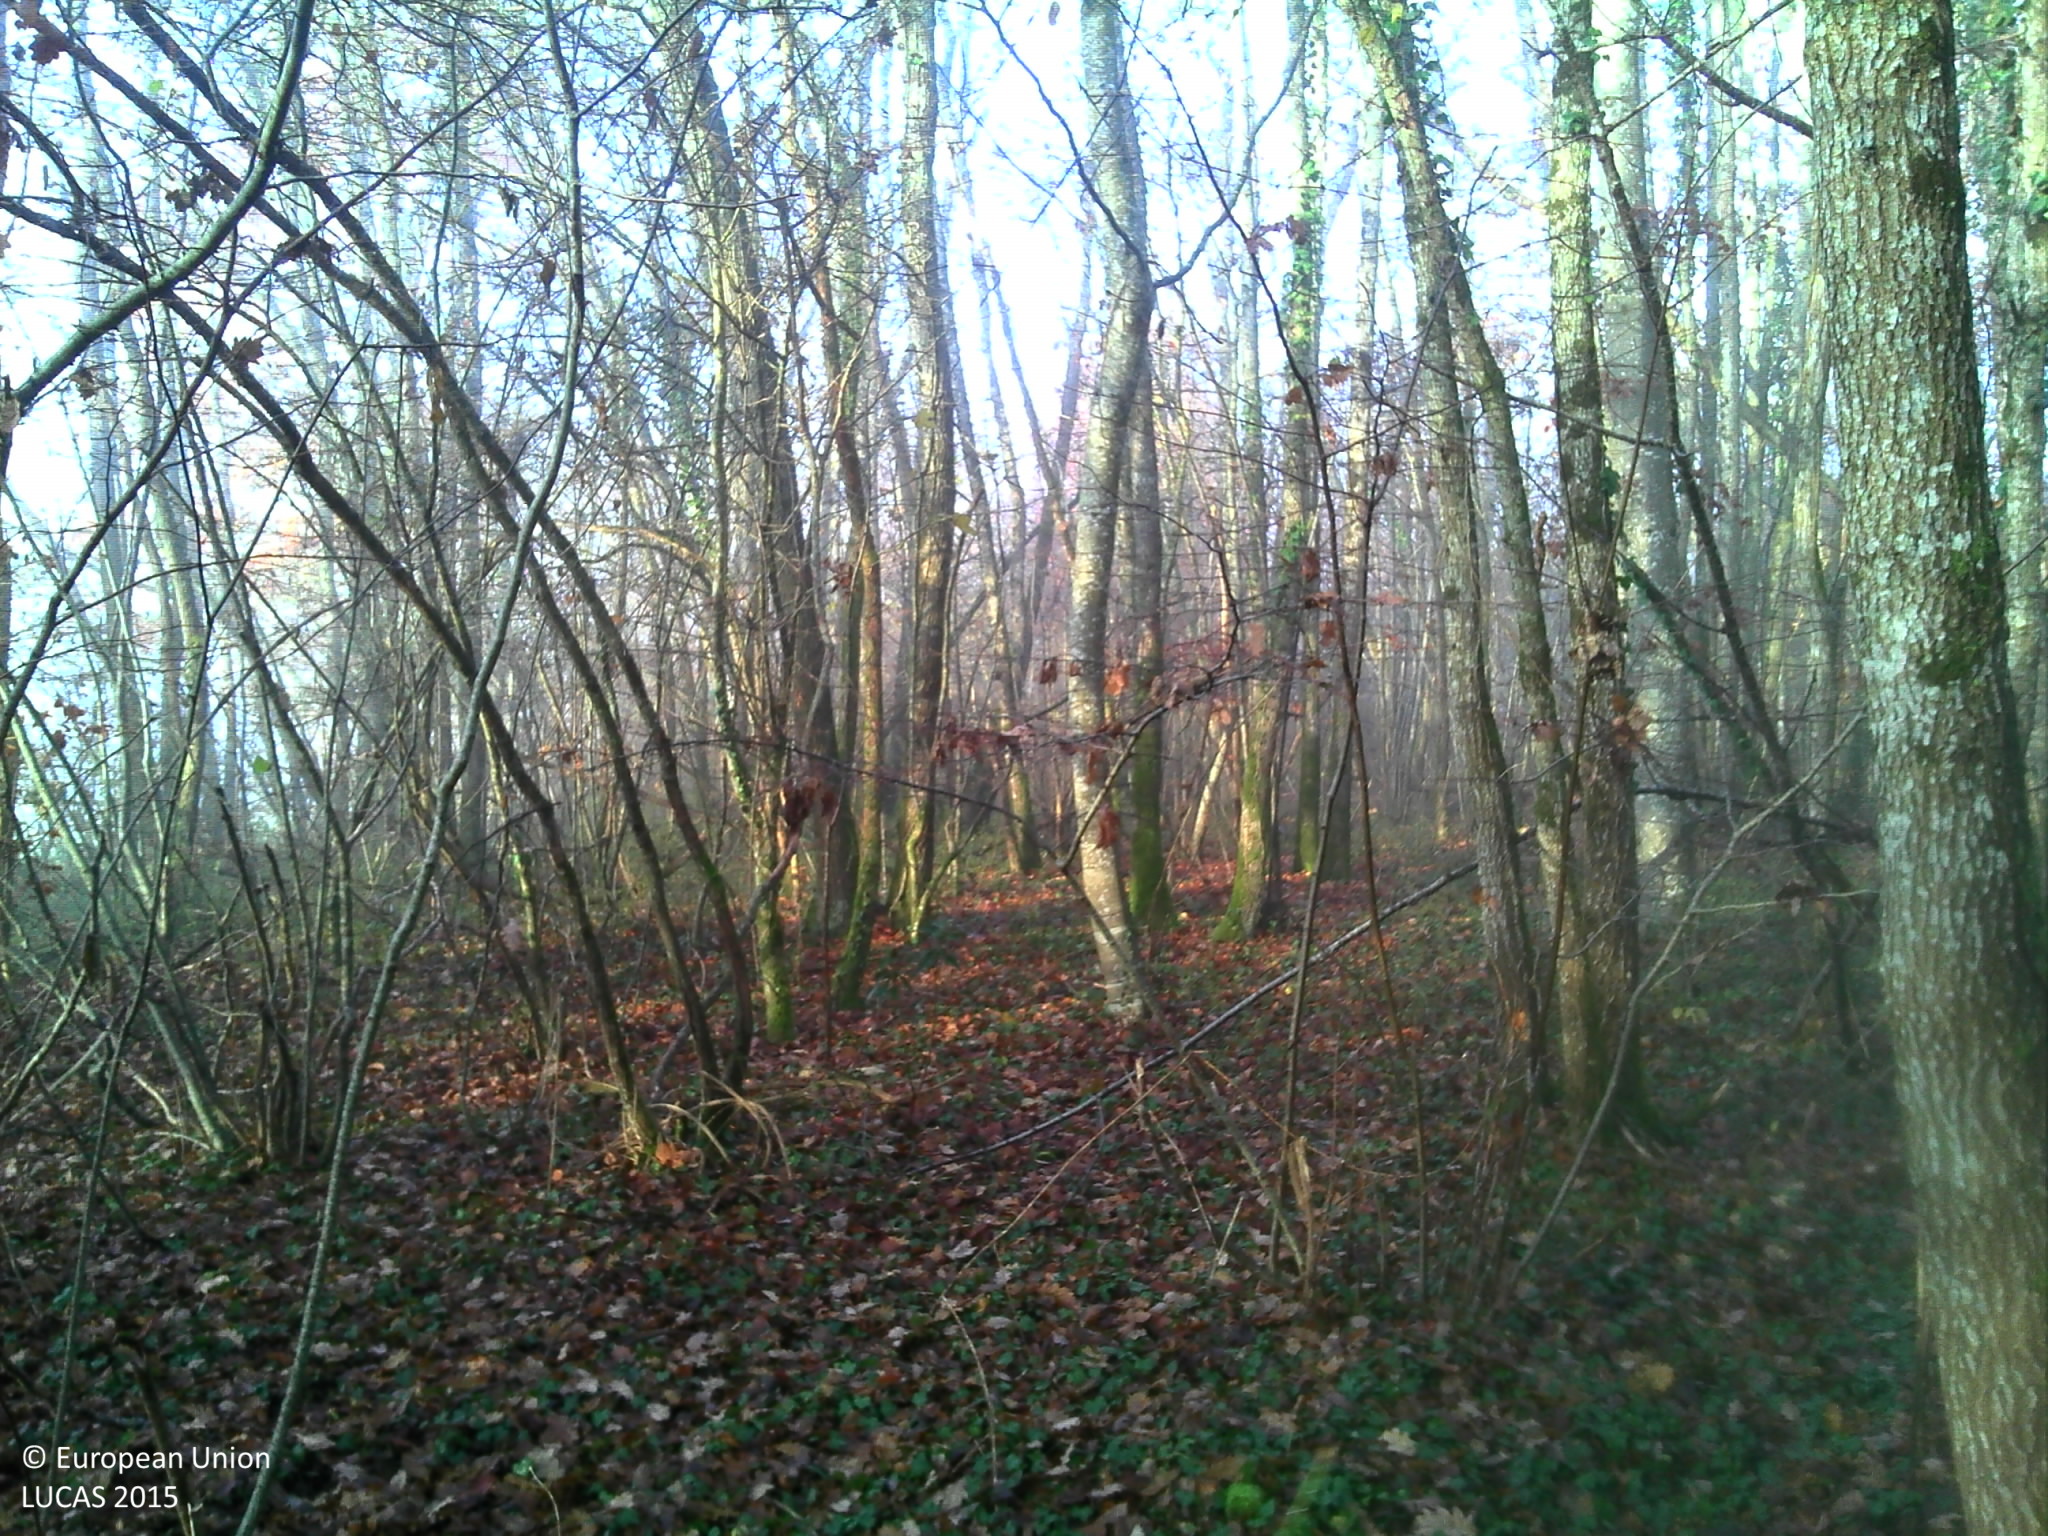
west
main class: Woodland
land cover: Broadleaved woodland
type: mesophytic deciduous forest
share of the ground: > 75 %
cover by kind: broadleaved forest trees 100 %
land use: Forestry
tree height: > 5 m
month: December
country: FR
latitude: 47.4514
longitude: 3.1646
